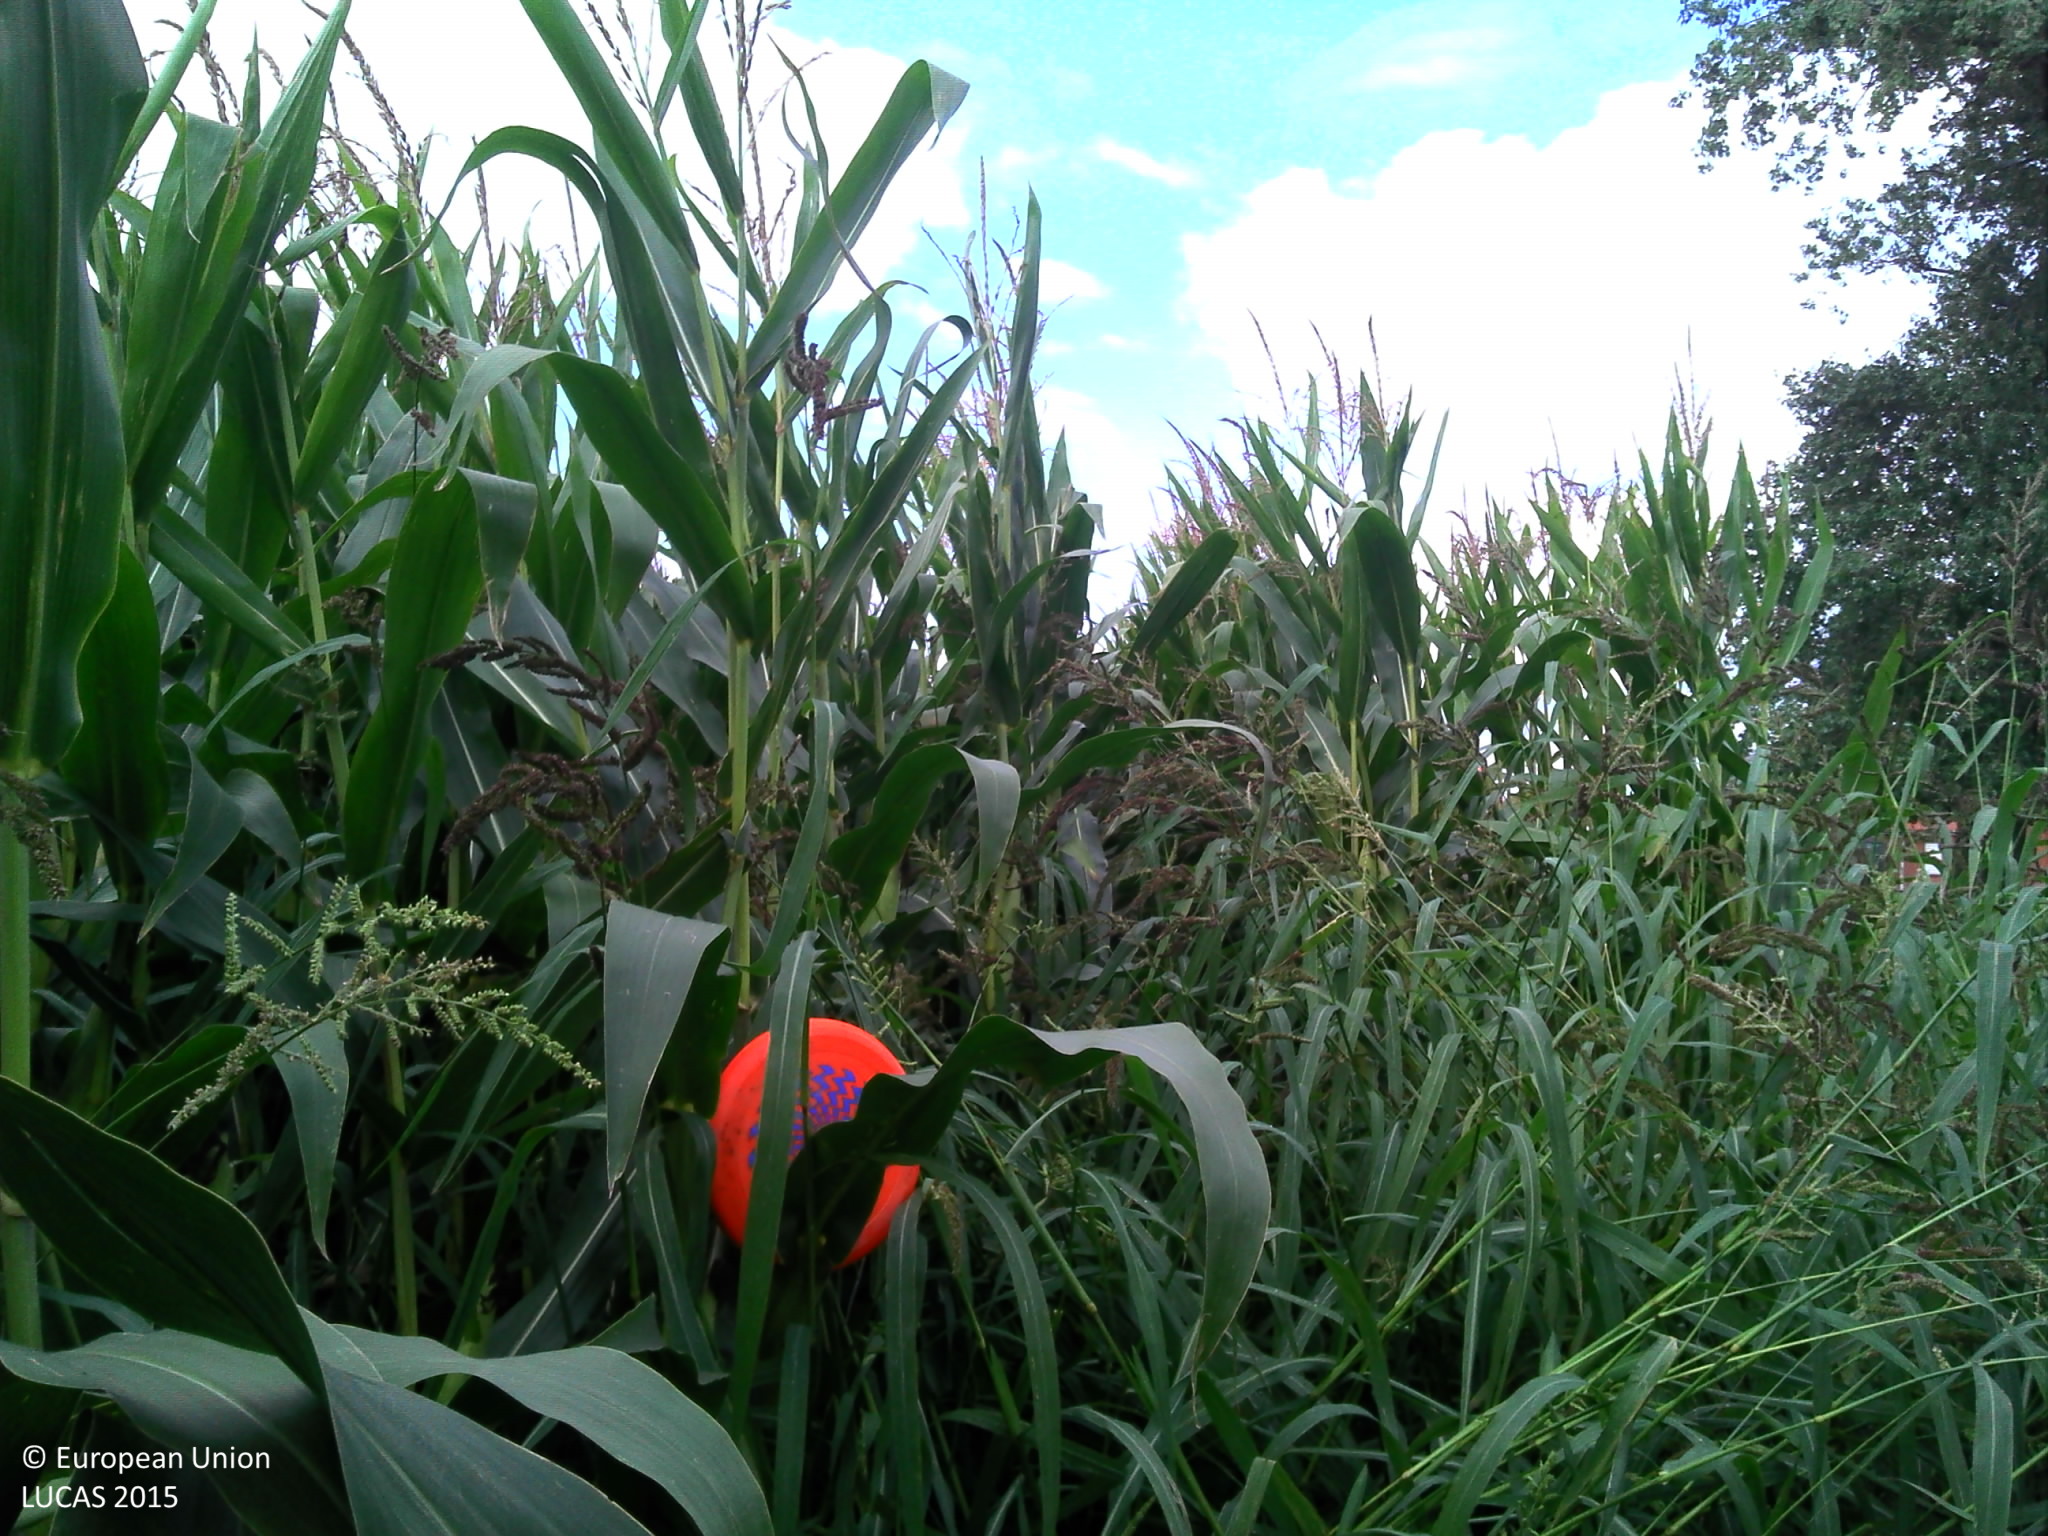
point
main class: Cropland
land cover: Maize
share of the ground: > 75 %
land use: Agriculture (excluding fallow land and kitchen gardens)
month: September
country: BE
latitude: 50.9084
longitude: 2.7212
